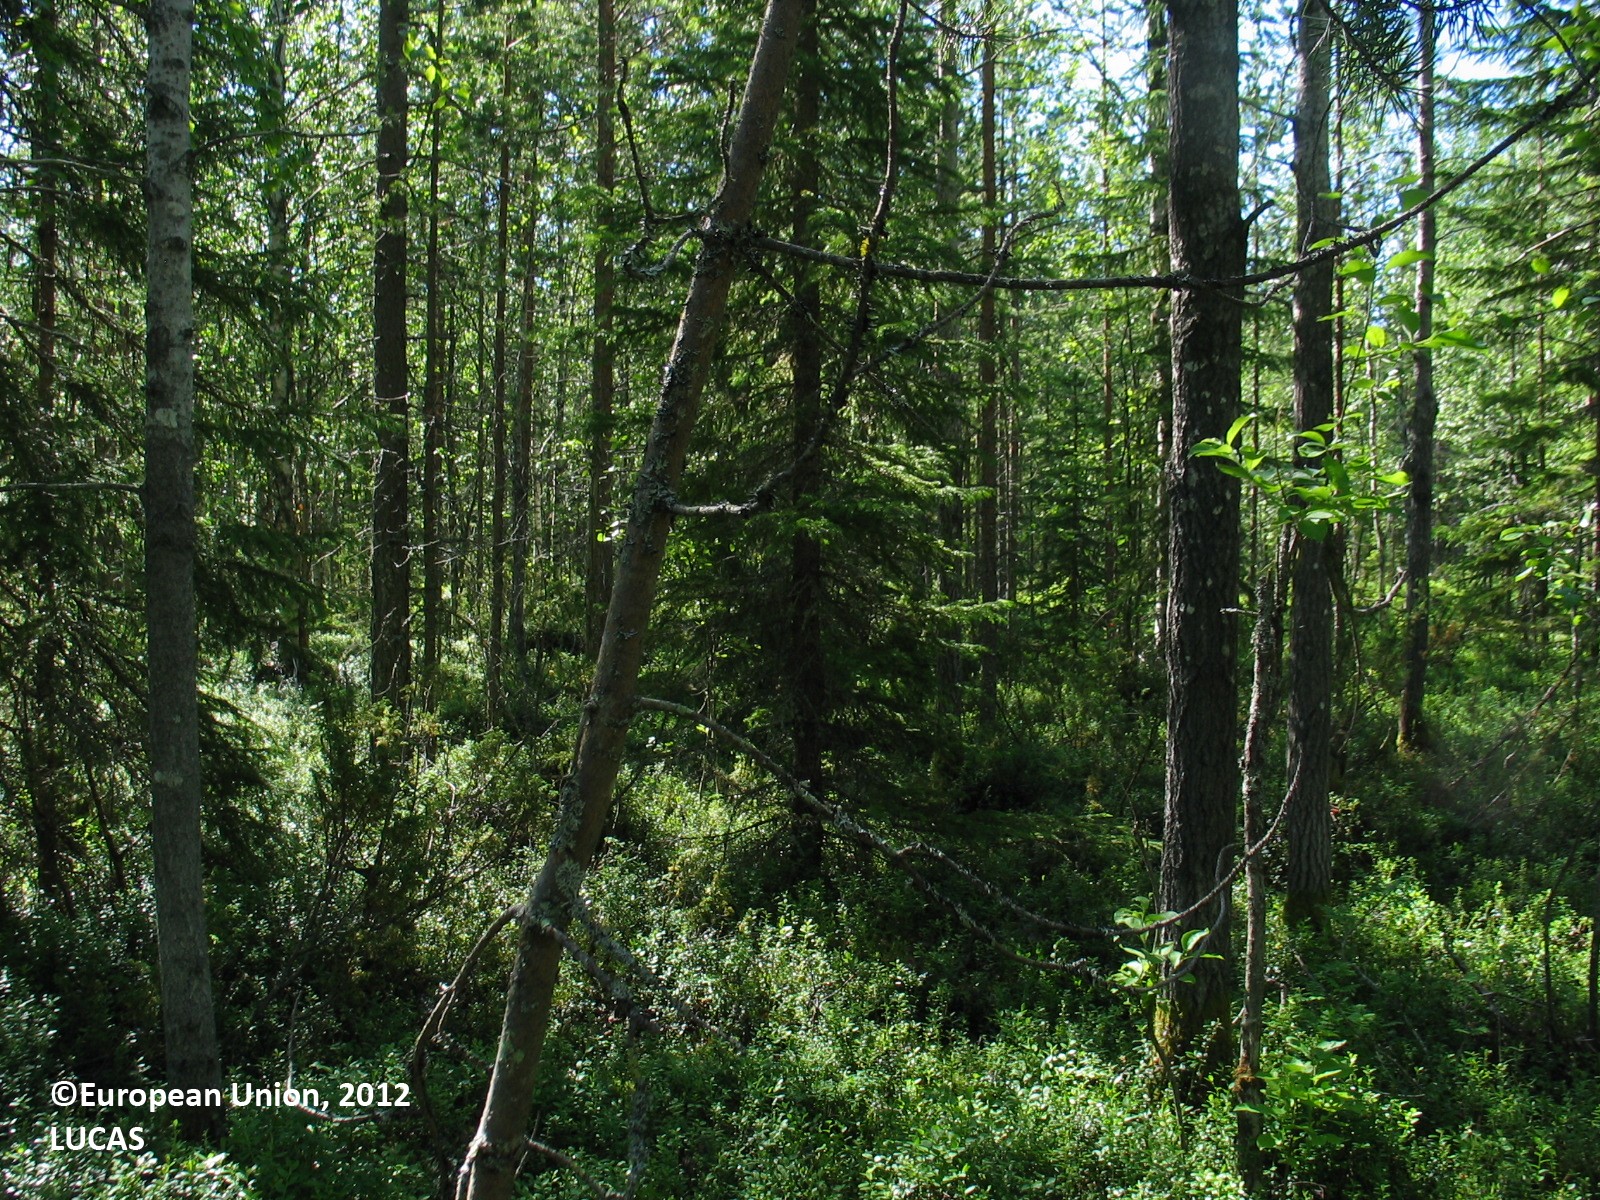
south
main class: Woodland
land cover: Pine dominated mixed woodland
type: boreal forest
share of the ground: 50 - 75 %
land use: Forestry
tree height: > 5 m
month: July
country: FI
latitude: 65.7828
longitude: 25.0297
